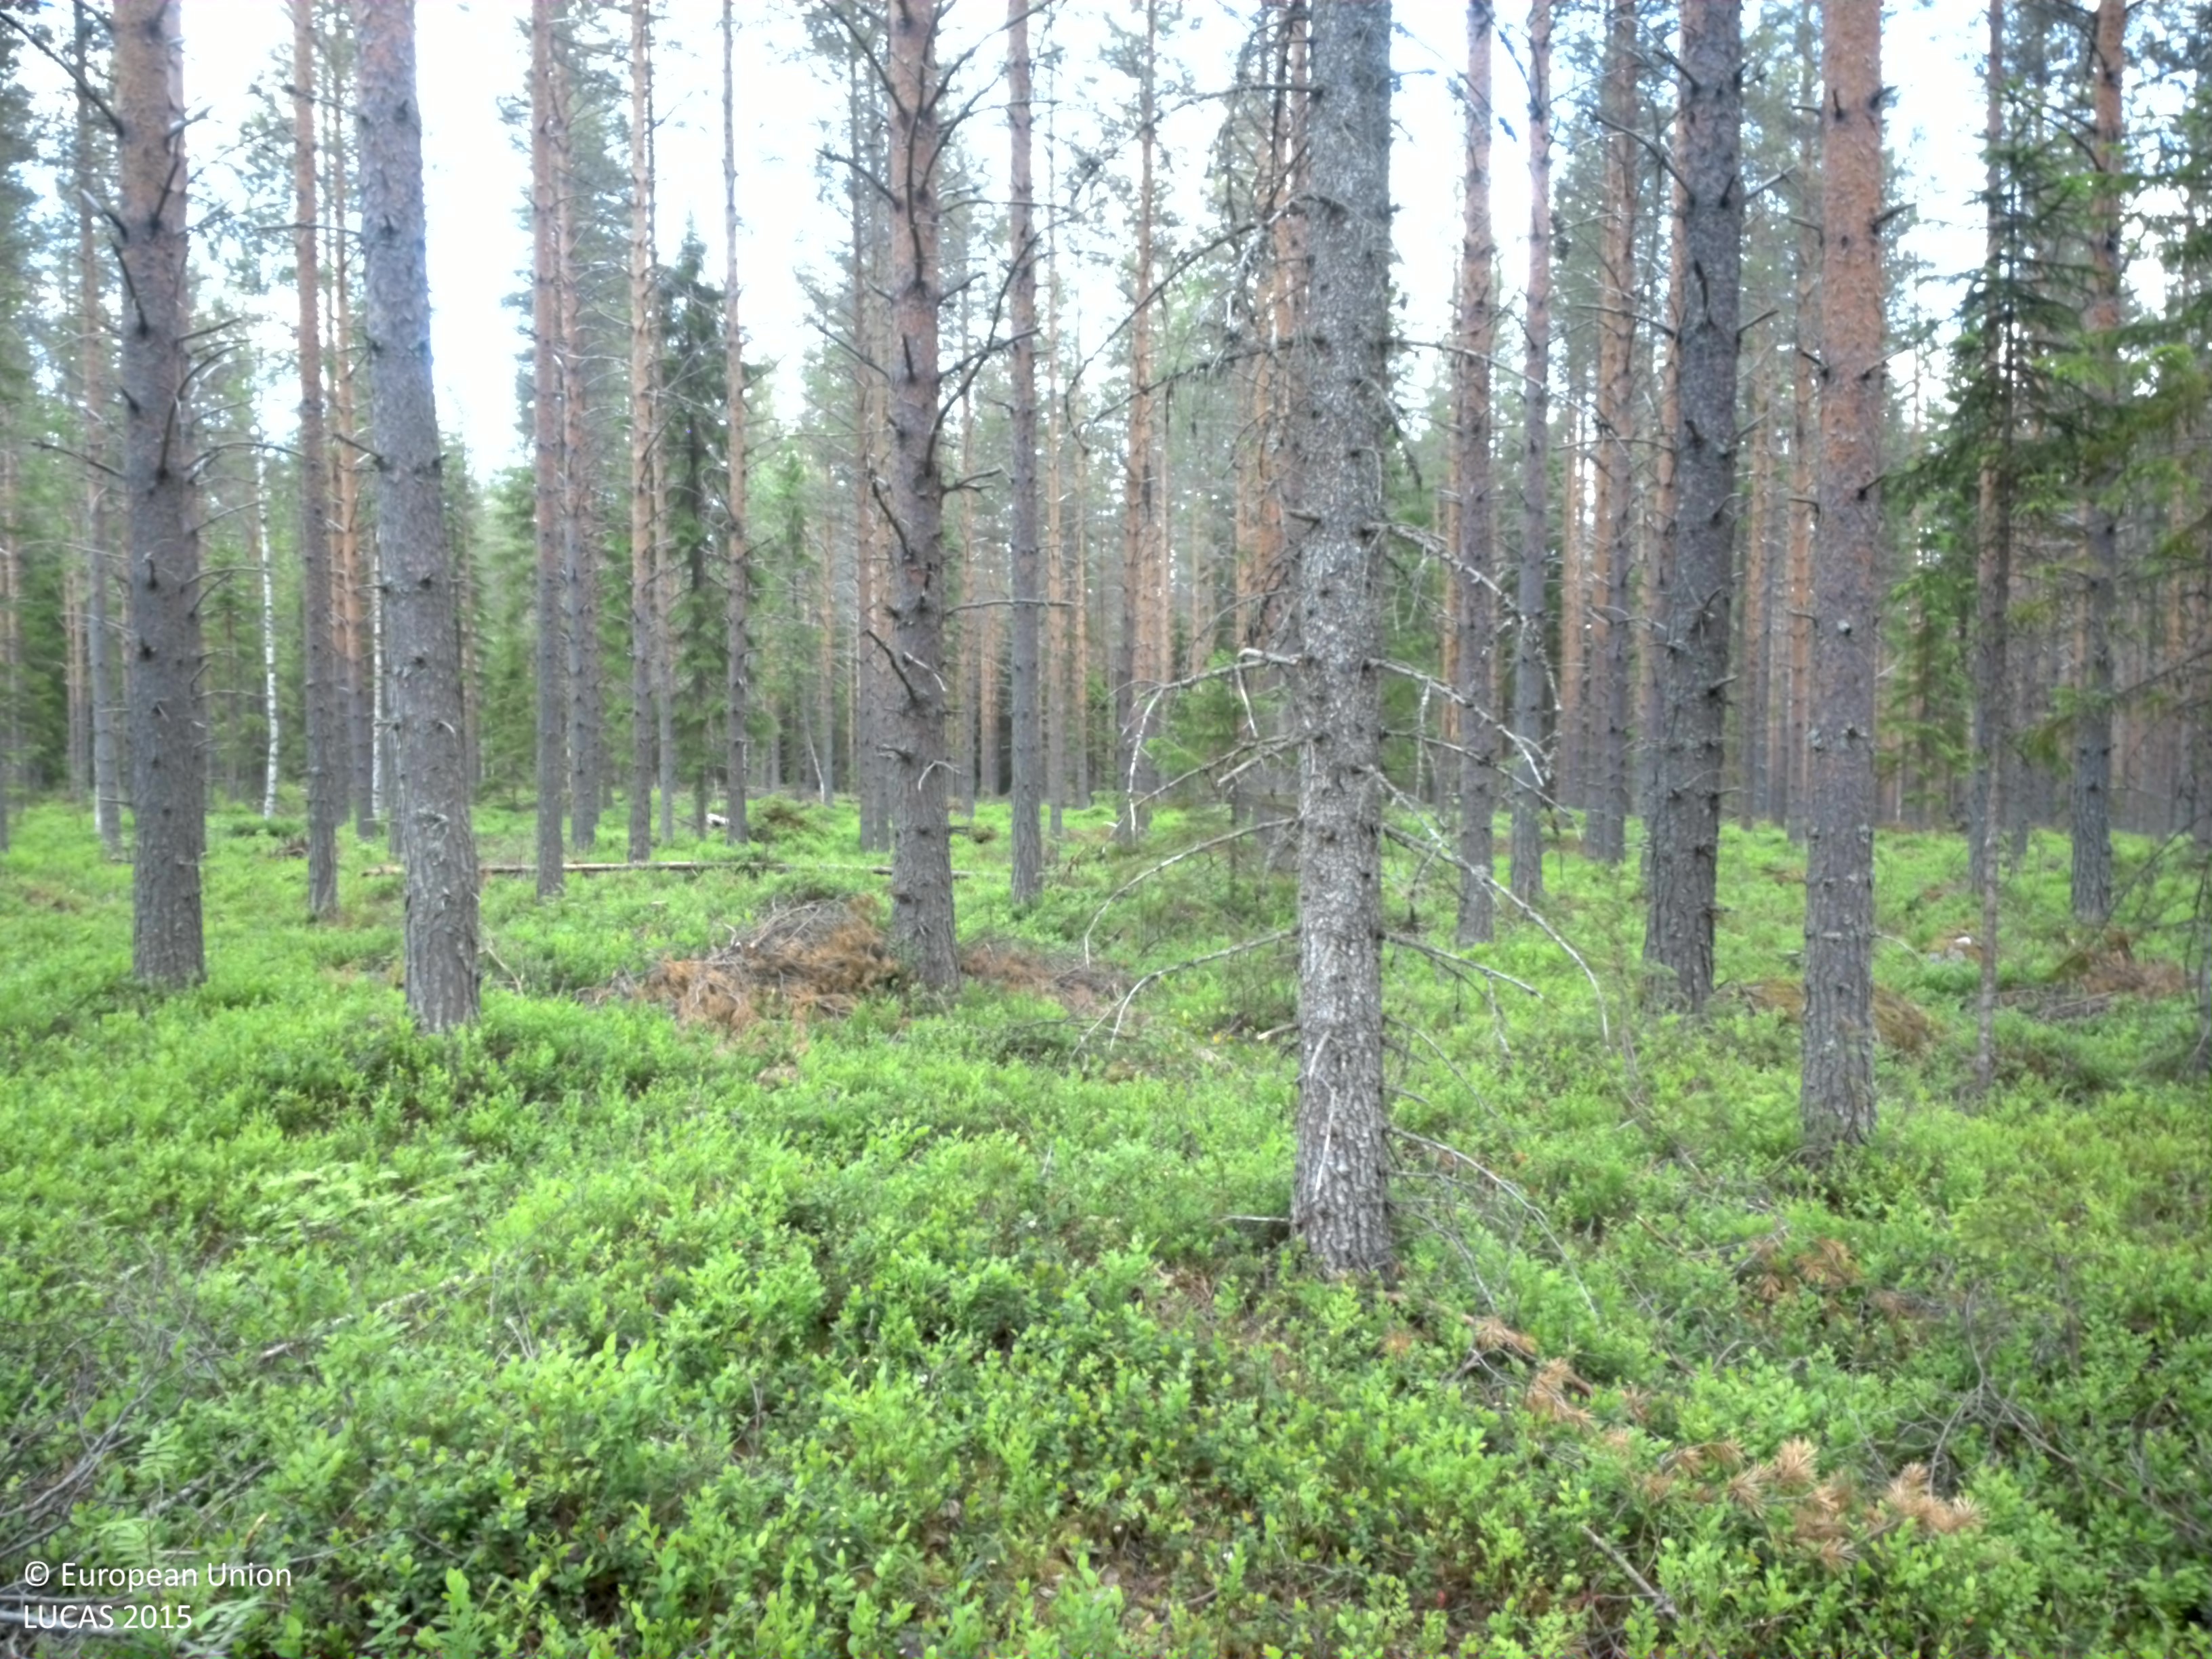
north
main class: Woodland
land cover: Pine dominated coniferous woodland
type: boreal forest
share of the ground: 50 - 75 %
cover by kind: coniferous forest trees 60 %, shrubs 40 %
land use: Forestry
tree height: > 5 m
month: July
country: SE
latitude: 64.3416
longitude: 20.7647
